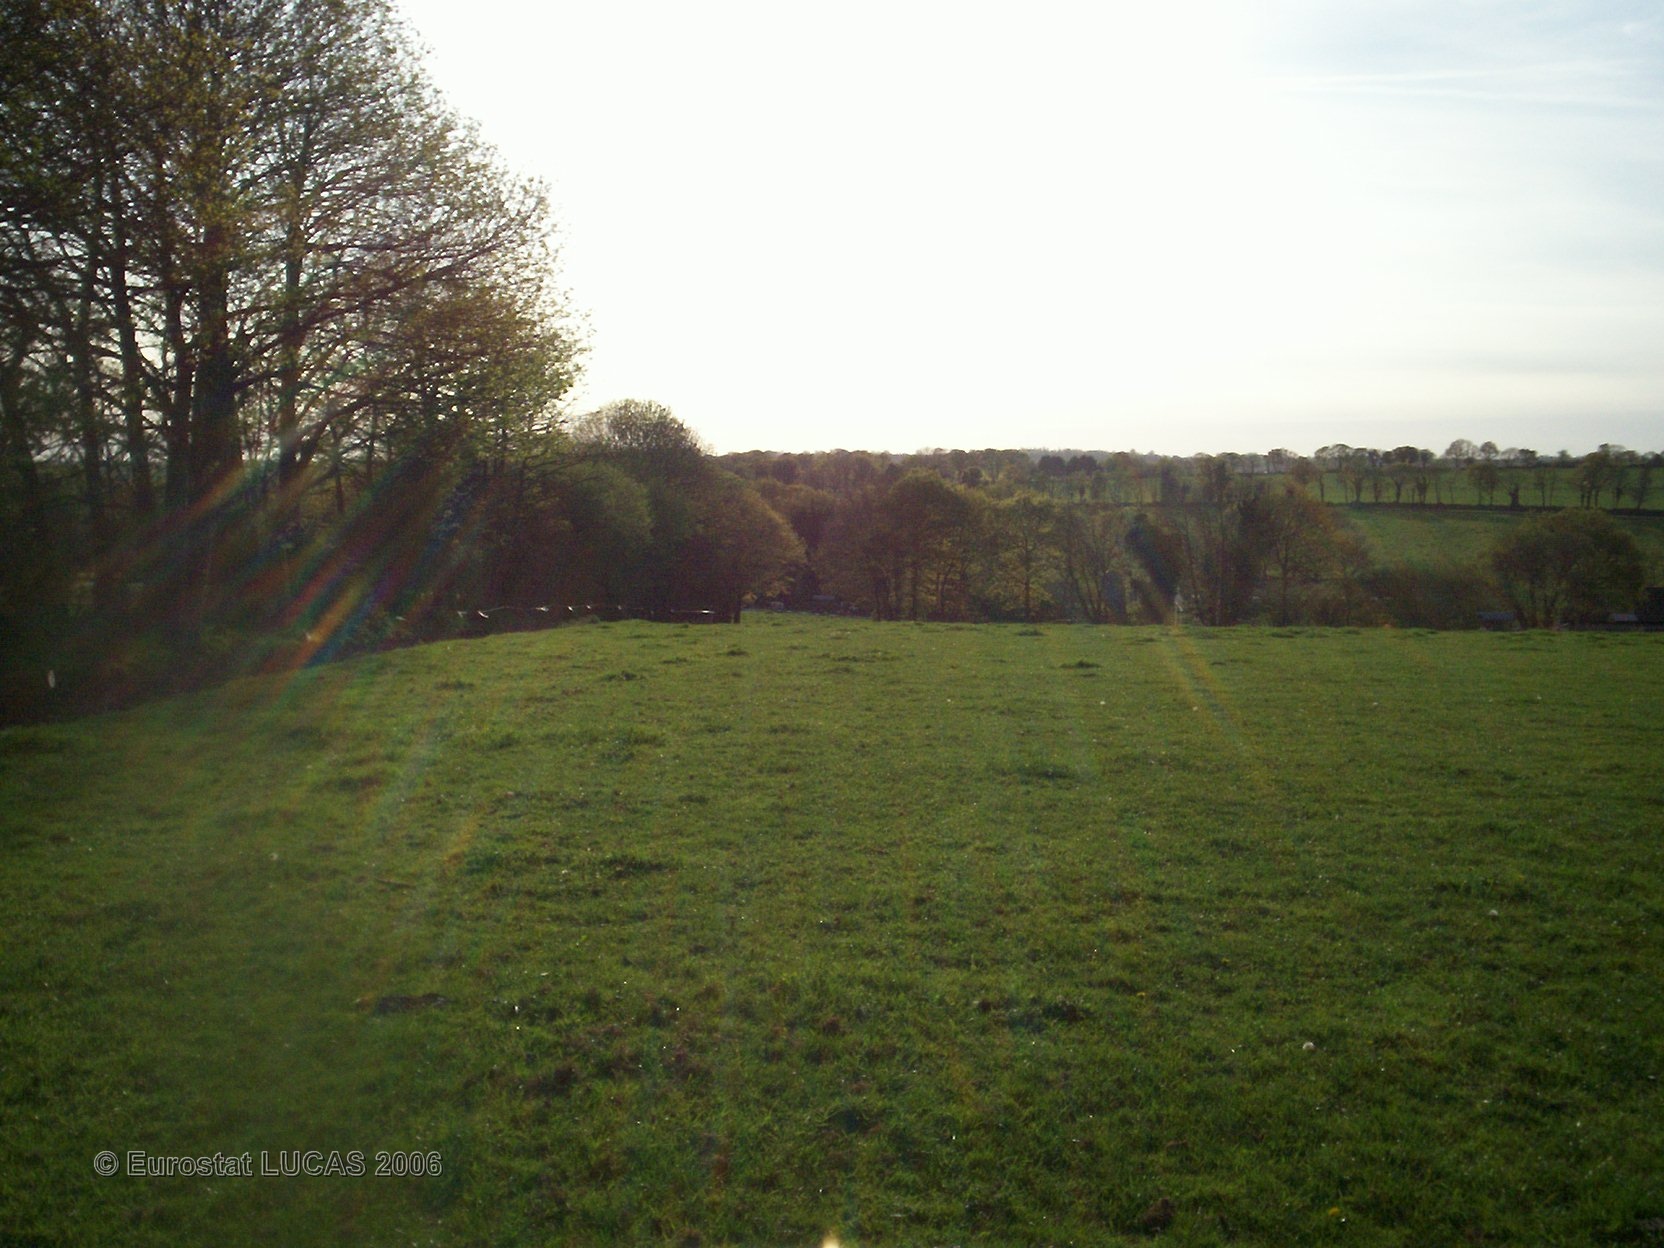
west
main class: Grassland
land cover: Grassland without tree/shrub cover
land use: Agriculture (excluding fallow land and kitchen gardens)
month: May
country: FR
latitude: 47.9945
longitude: -2.8635
